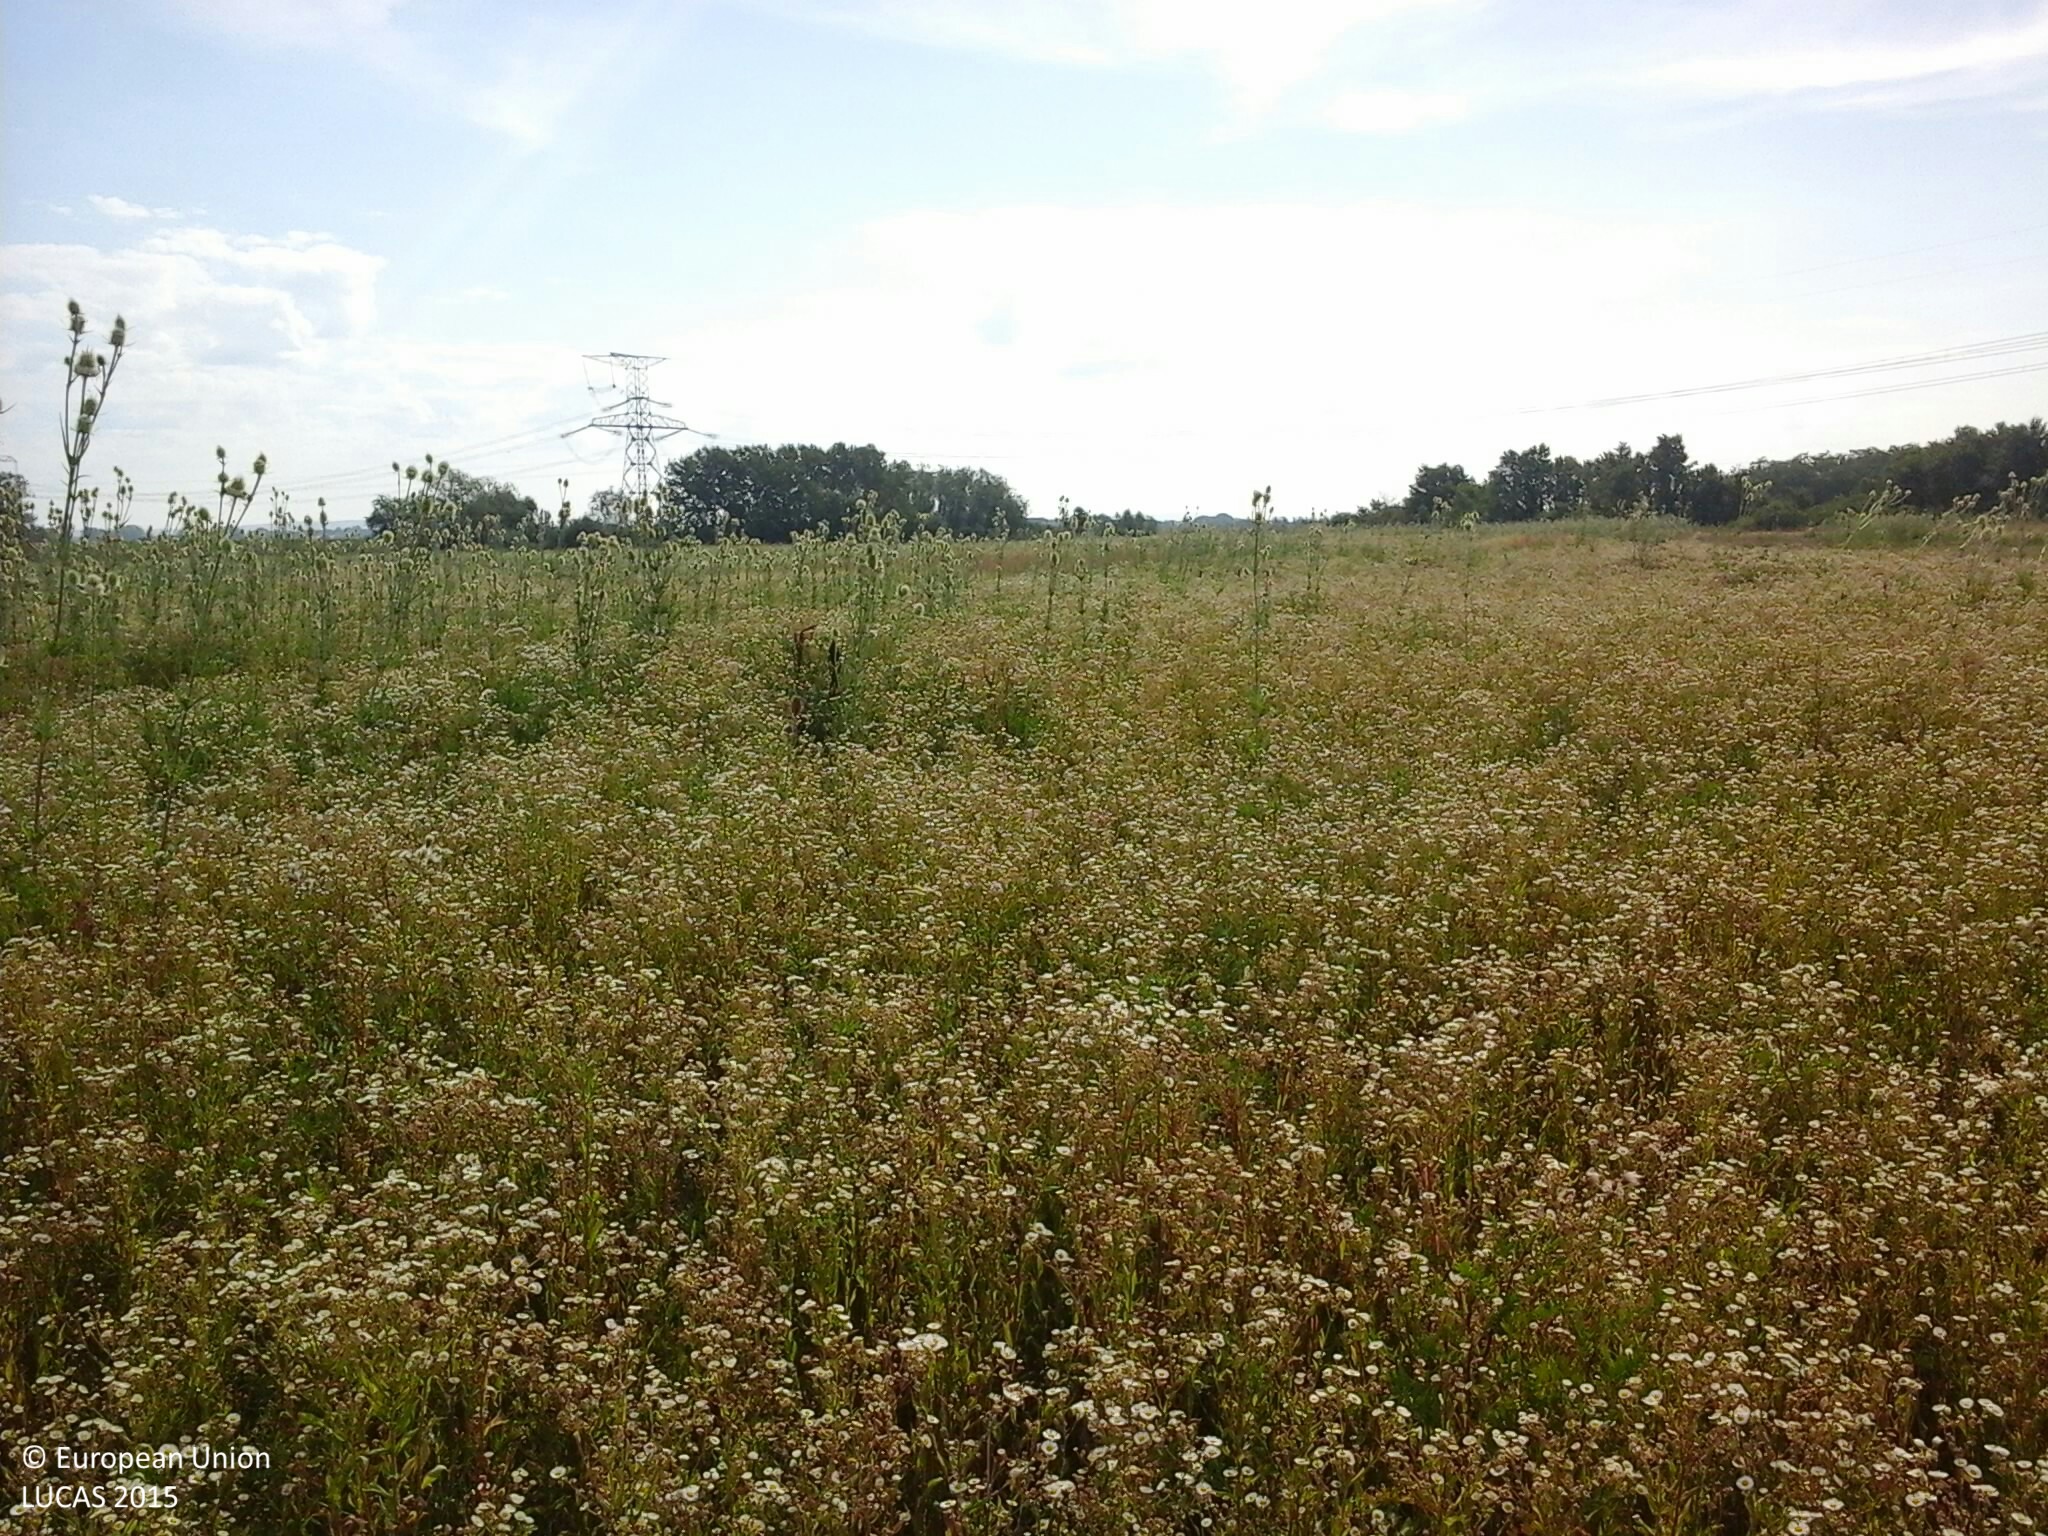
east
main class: Grassland
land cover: Spontaneously vegetated surfaces
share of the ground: > 75 %
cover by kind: herbaceous plants 100 %
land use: Abandoned areas
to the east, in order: Spontaneously vegetated surfaces; Electric lines; Spontaneously vegetated surfaces
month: July
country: HU
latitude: 48.2210
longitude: 22.3199
